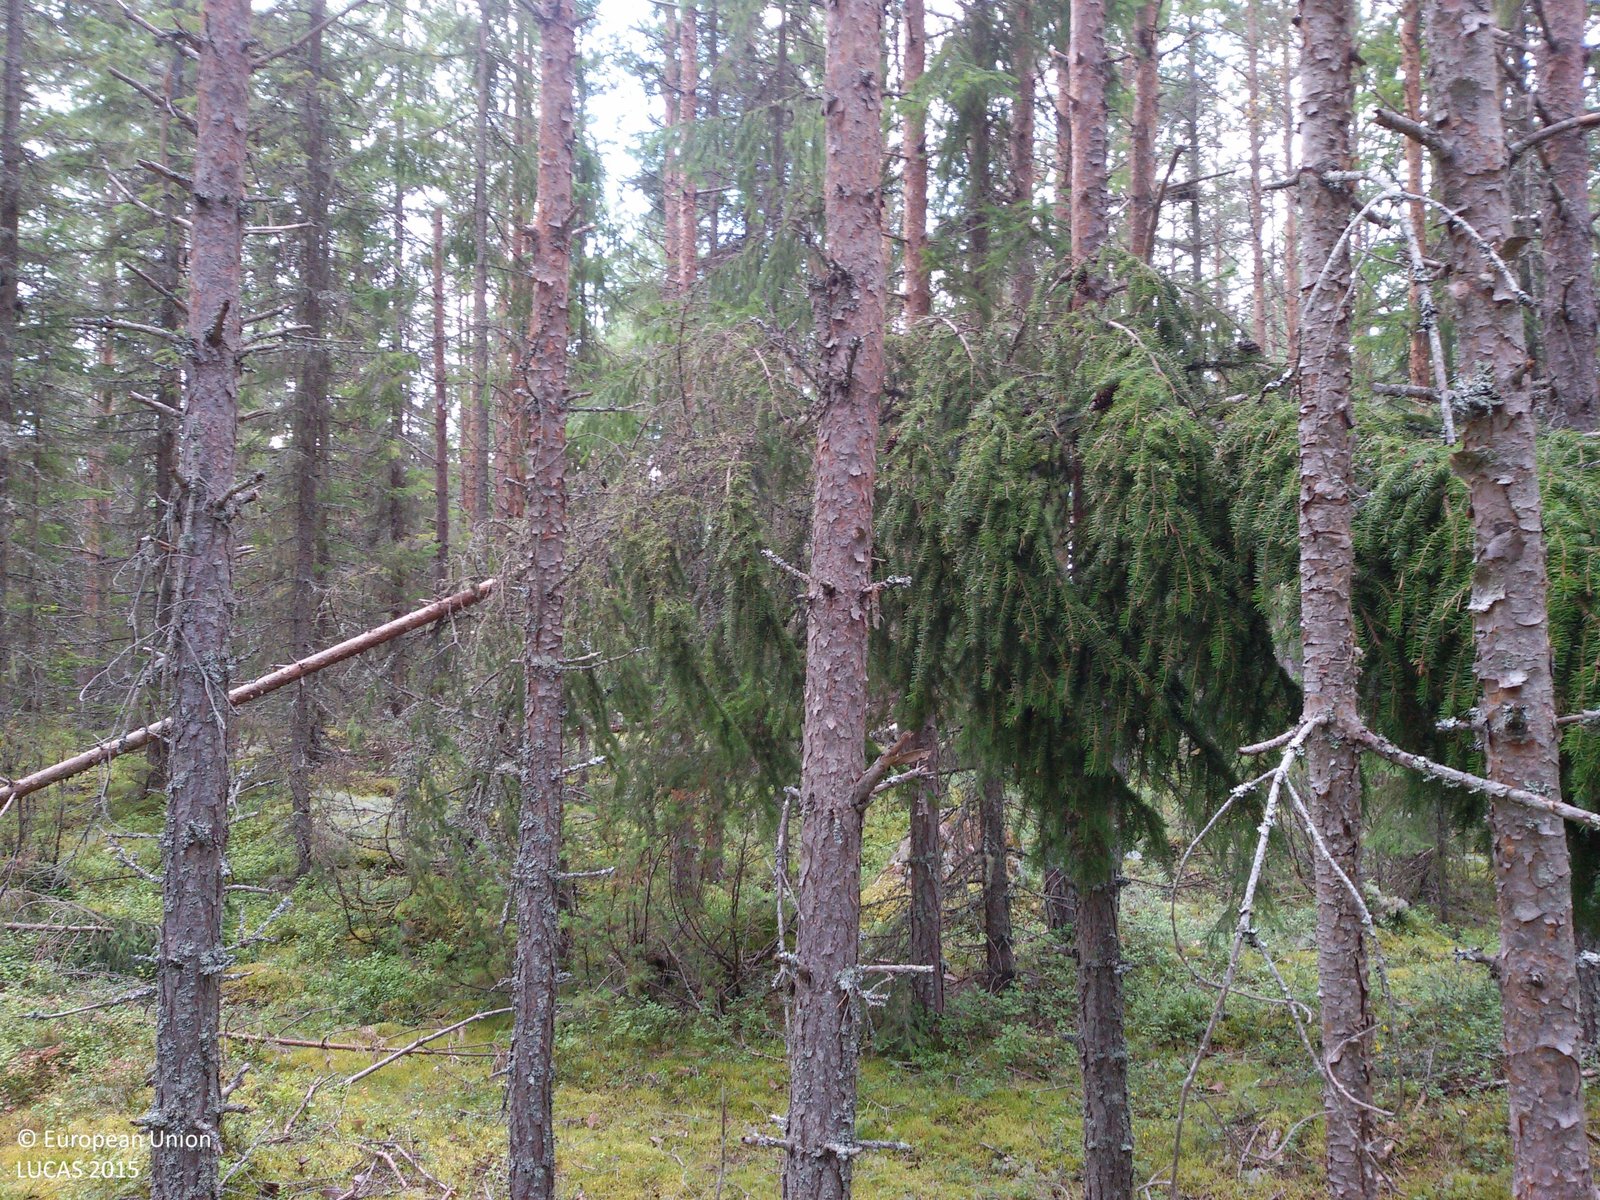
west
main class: Woodland
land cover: Pine dominated coniferous woodland
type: boreal forest
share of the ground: > 75 %
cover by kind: coniferous forest trees 80 %, lichens and mosses 10 %, shrubs 5 %, herbaceous plants 5 %
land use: Forestry
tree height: > 5 m
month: August
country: SE
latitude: 60.8220
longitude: 16.5886
